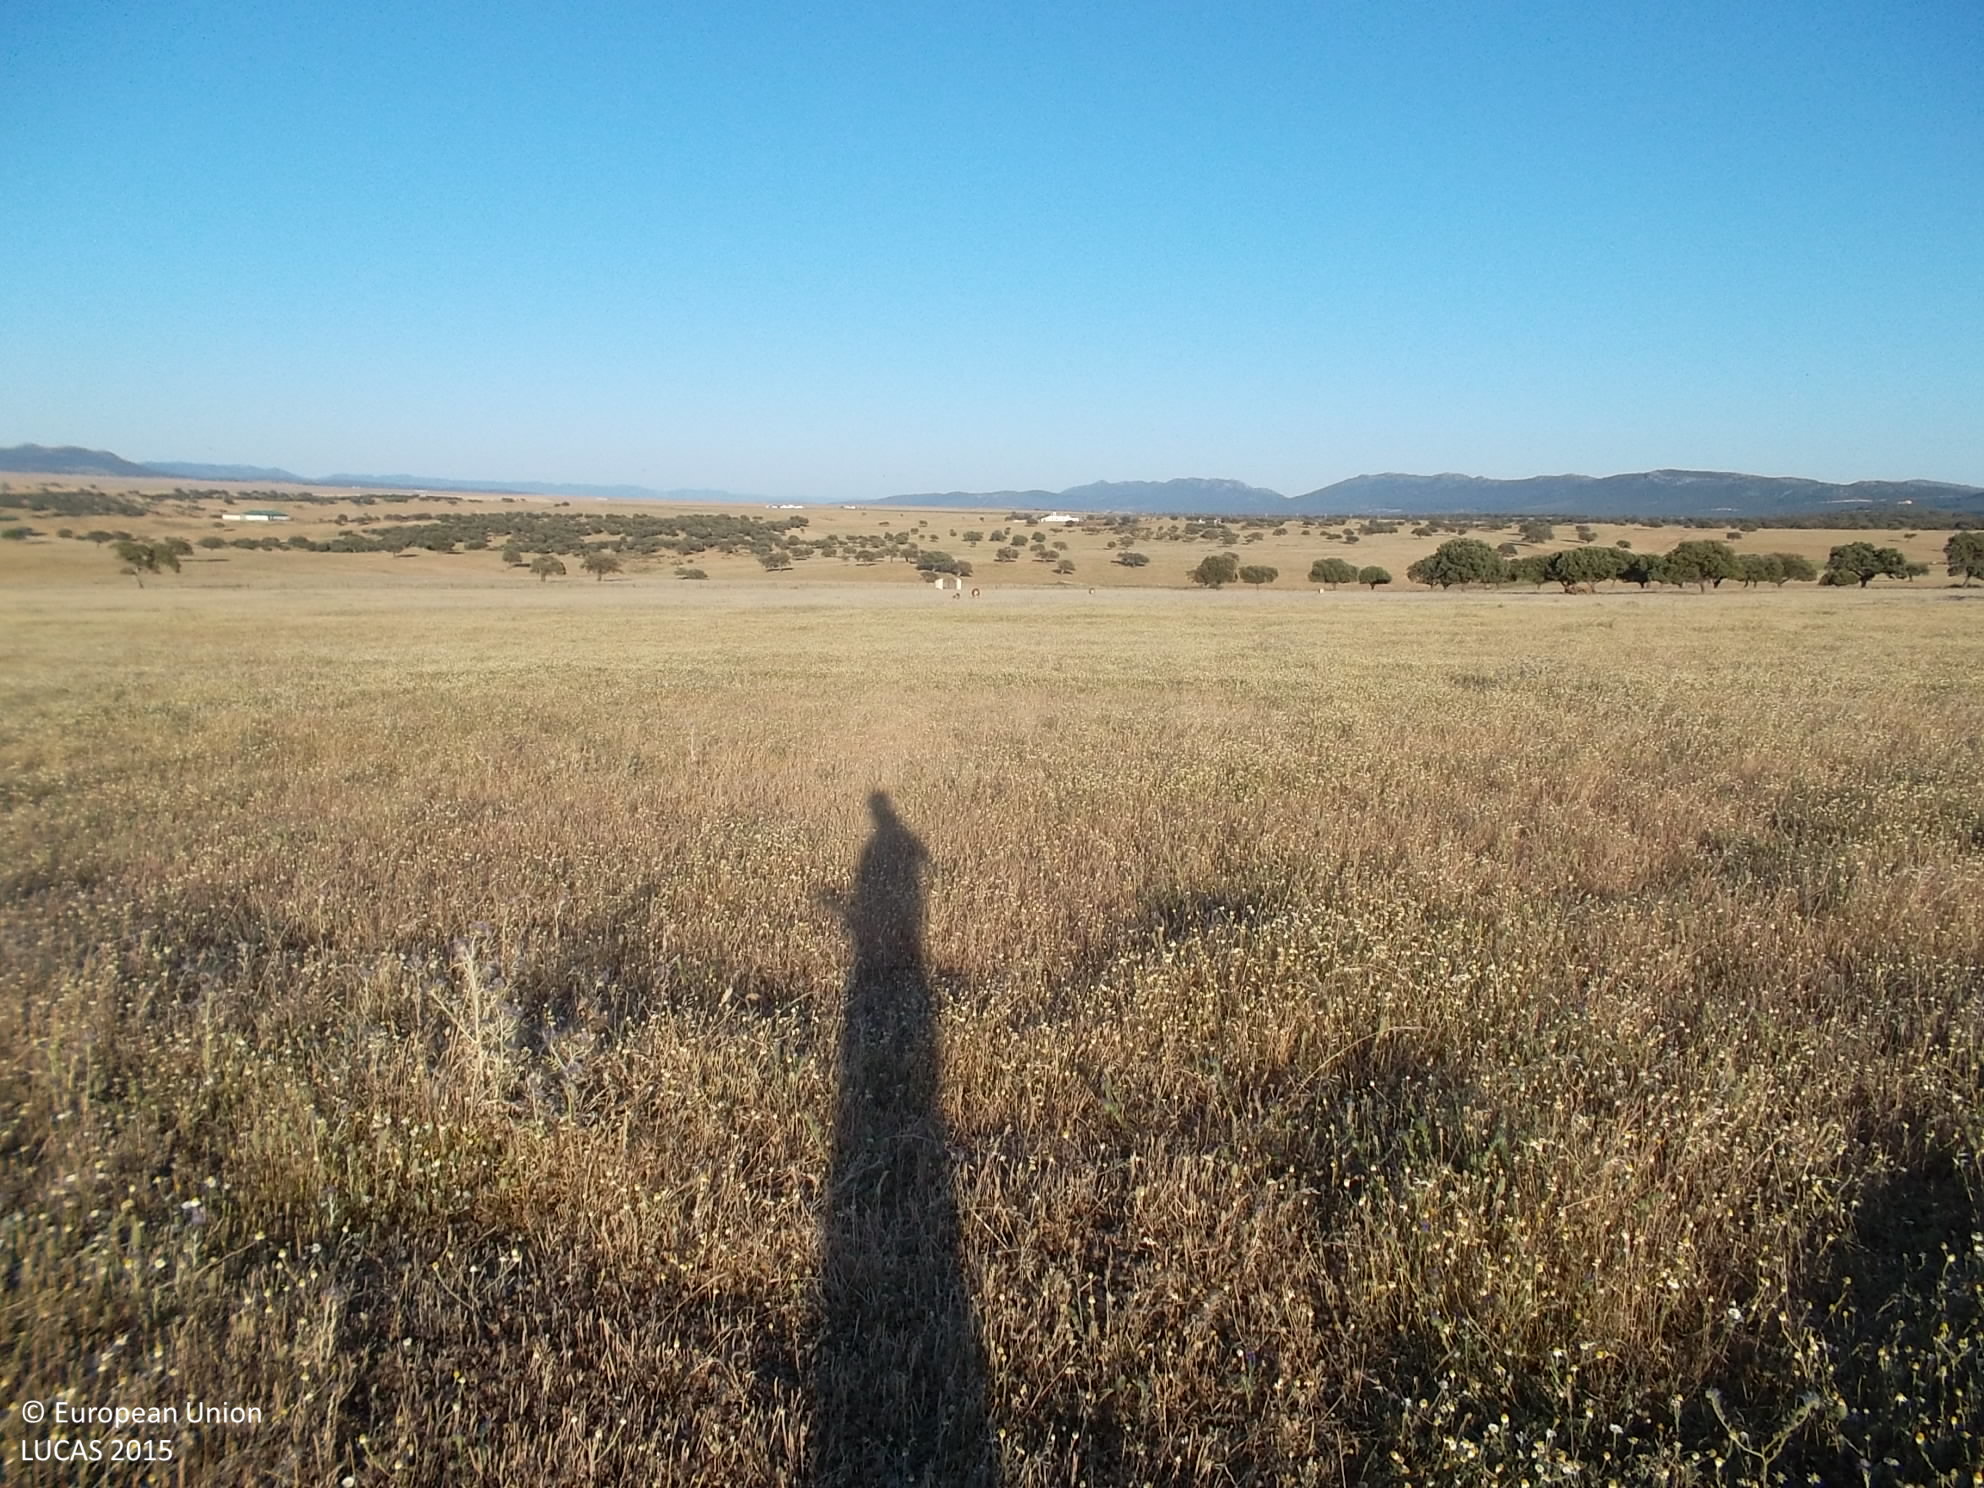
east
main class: Grassland
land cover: Grassland without tree/shrub cover
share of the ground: > 75 %
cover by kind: herbaceous plants 100 %
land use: Agriculture (excluding fallow land and kitchen gardens)
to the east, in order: Grassland without tree/shrub cover
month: May
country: ES
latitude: 38.6031
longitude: -4.4554
